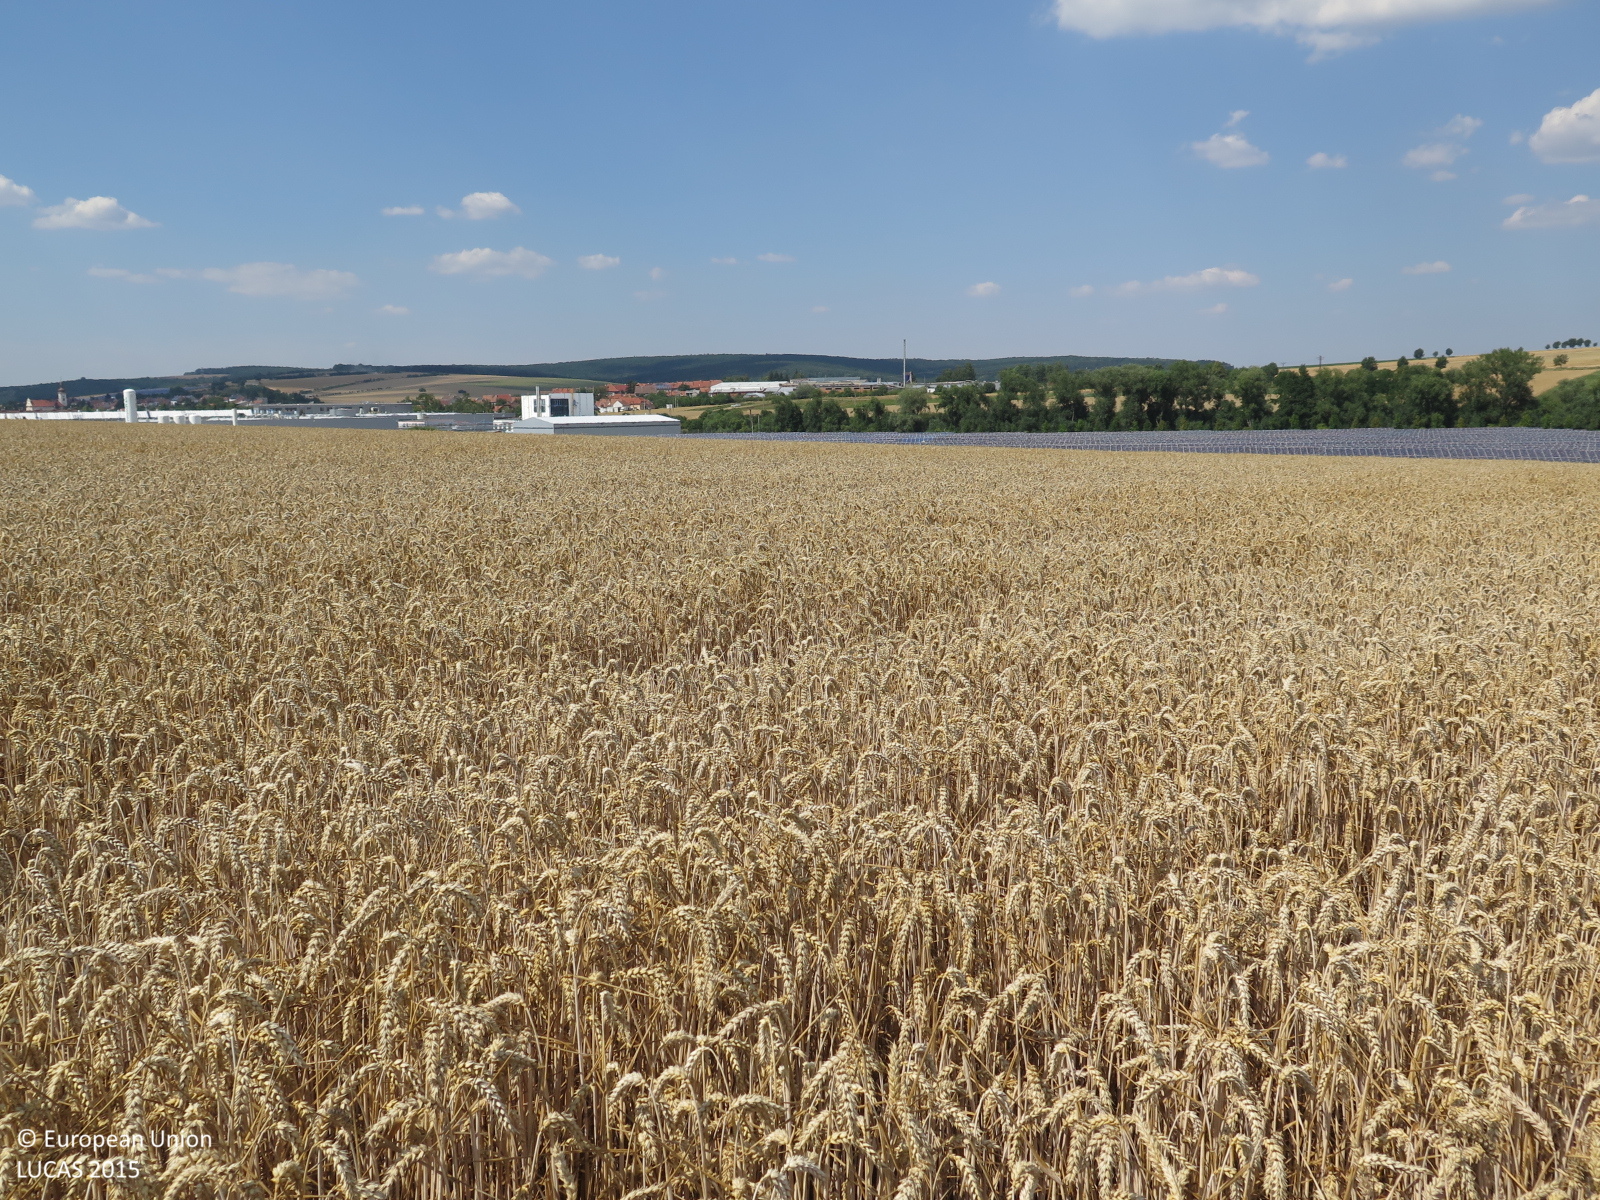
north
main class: Cropland
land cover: Common wheat
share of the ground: > 75 %
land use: Agriculture (excluding fallow land and kitchen gardens)
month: July
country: CZ
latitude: 48.9770
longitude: 17.5397
